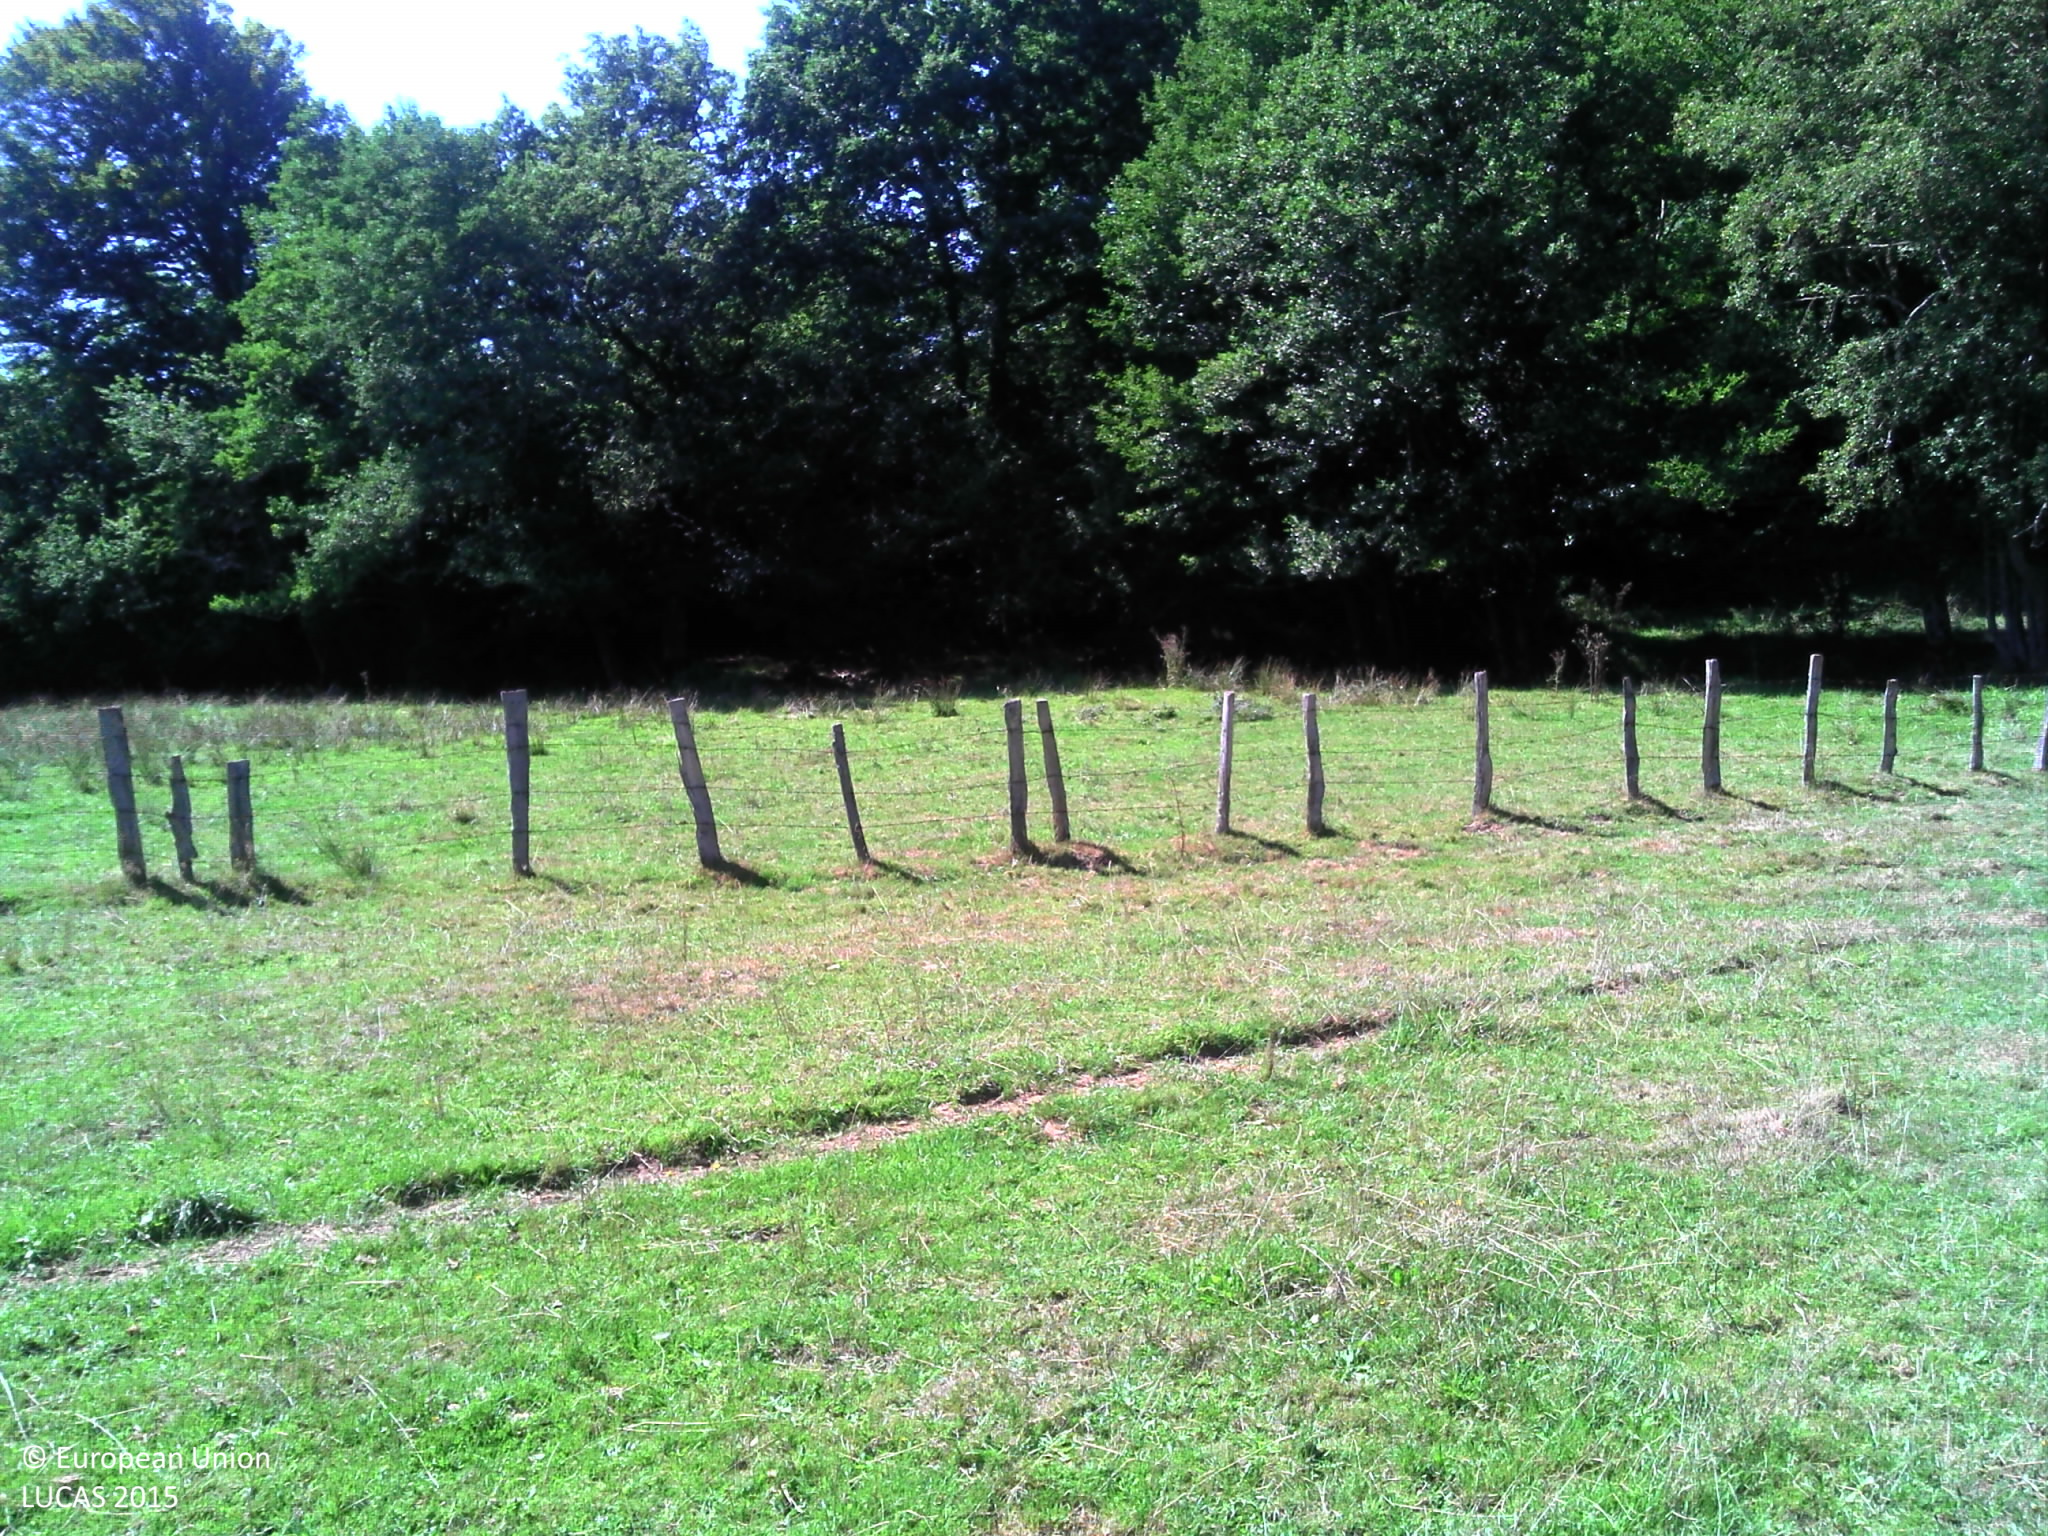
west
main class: Grassland
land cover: Grassland without tree/shrub cover
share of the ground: > 75 %
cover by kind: herbaceous plants 100 %
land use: Agriculture (excluding fallow land and kitchen gardens)
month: August
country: FR
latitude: 45.8710
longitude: 2.2537
